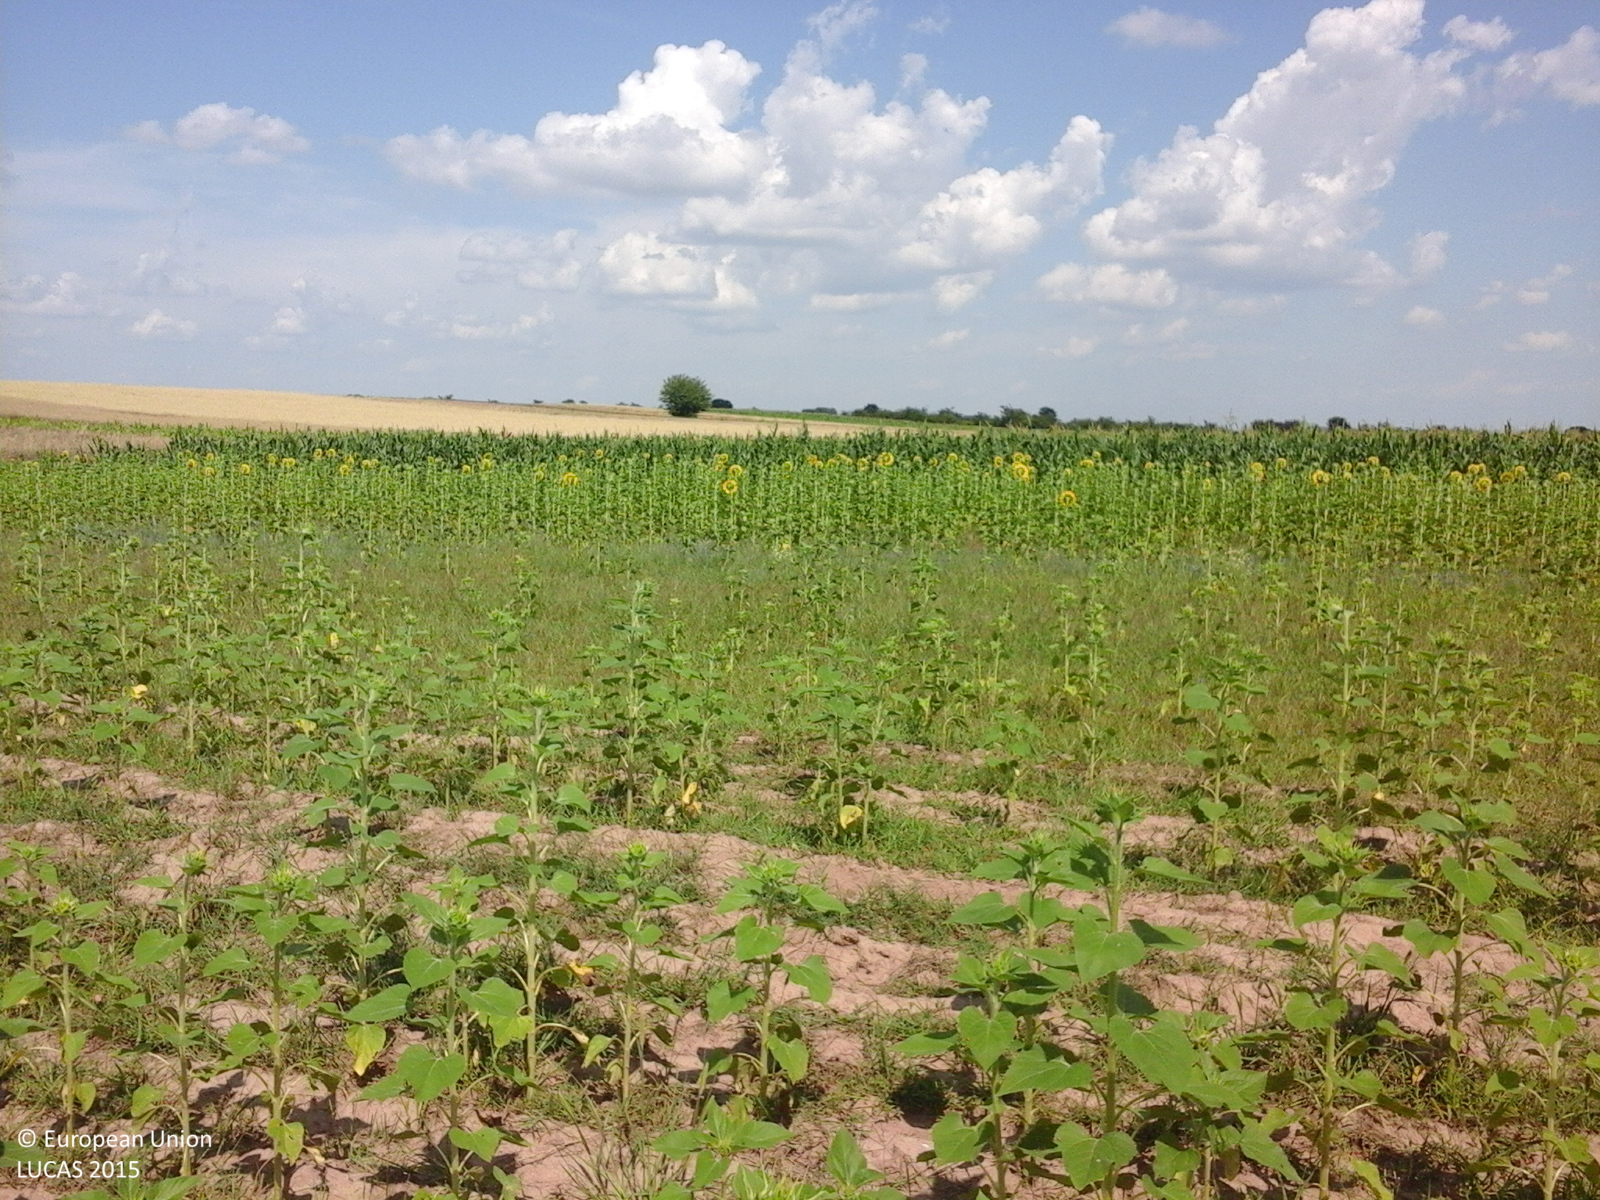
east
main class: Cropland
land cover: Sunflower
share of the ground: > 75 %
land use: Agriculture (excluding fallow land and kitchen gardens)
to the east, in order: Sunflower; Maize; Common wheat; Tracks; Common wheat
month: July
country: RO
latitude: 44.0196
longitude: 24.1190
